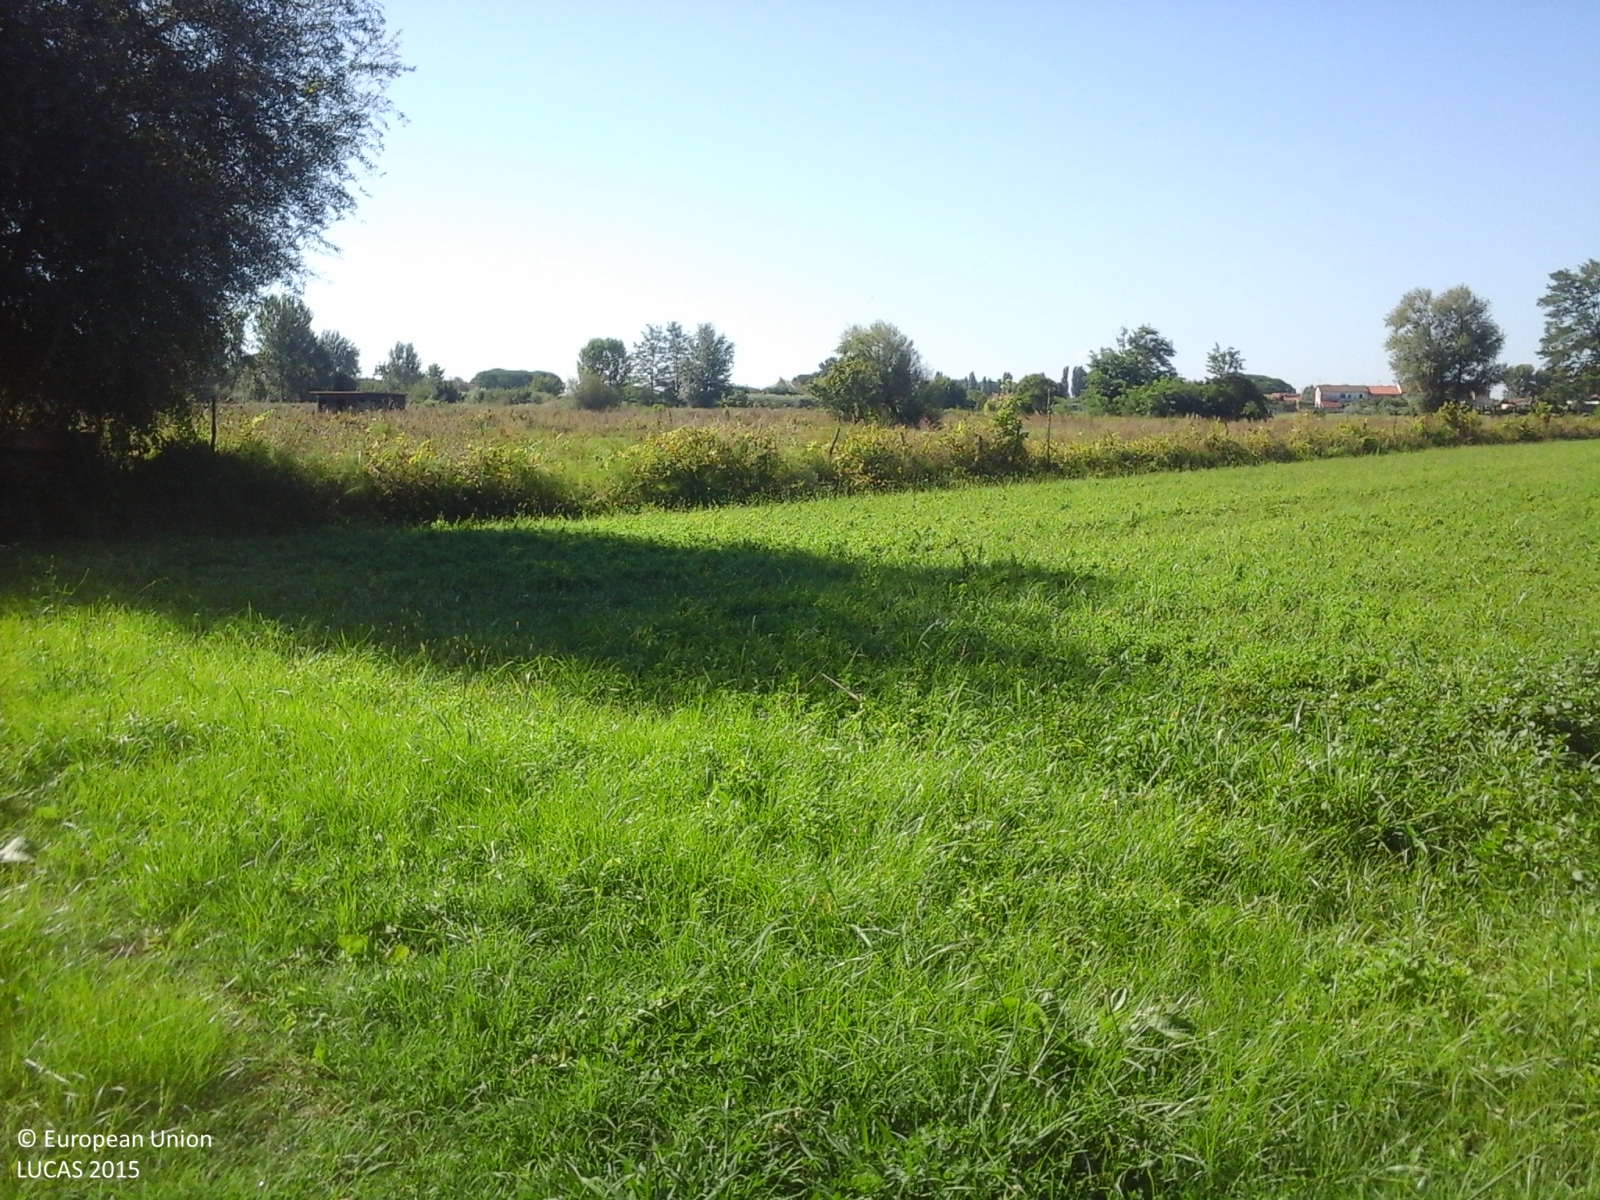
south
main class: Grassland
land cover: Grassland without tree/shrub cover
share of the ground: > 75 %
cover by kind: herbaceous plants 100 %
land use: Agriculture (excluding fallow land and kitchen gardens)
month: August
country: IT
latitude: 43.7726
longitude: 10.3593
